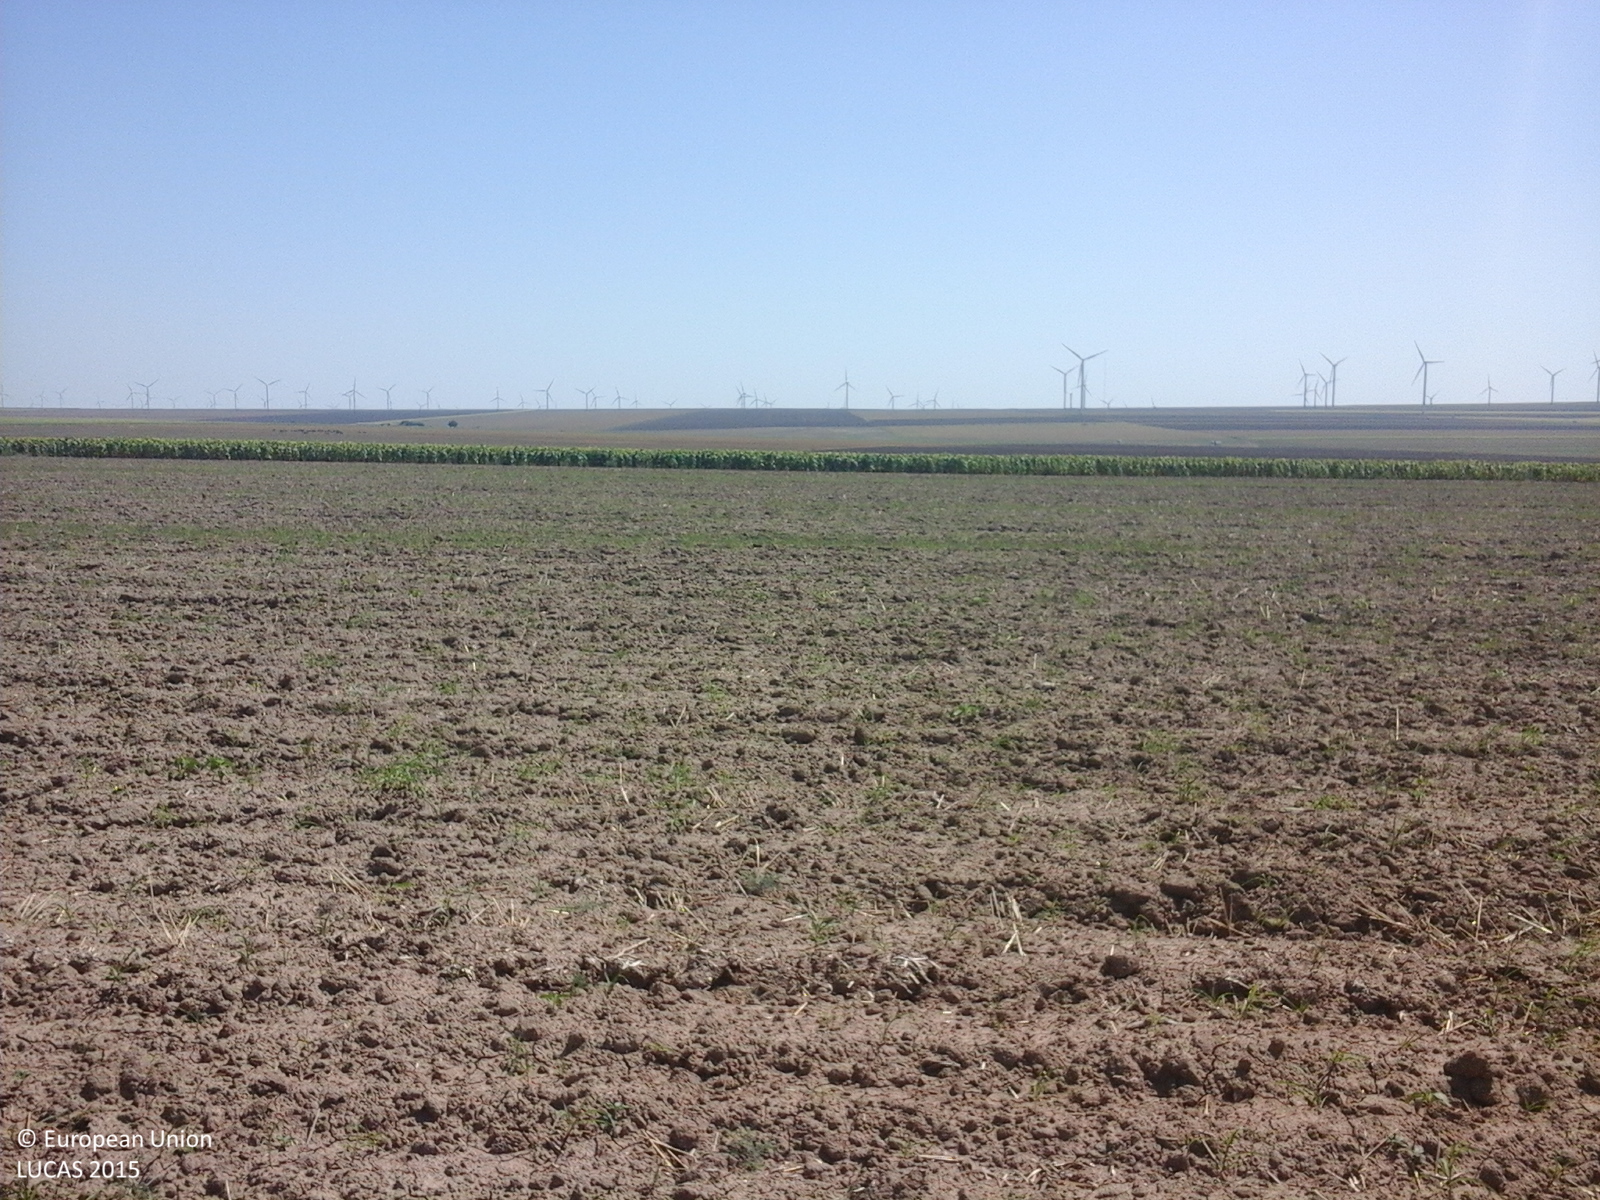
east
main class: Cropland
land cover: Durum wheat
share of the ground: < 10 %
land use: Agriculture (excluding fallow land and kitchen gardens)
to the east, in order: Durum wheat; Sunflower
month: August
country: RO
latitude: 44.5807
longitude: 28.4474
